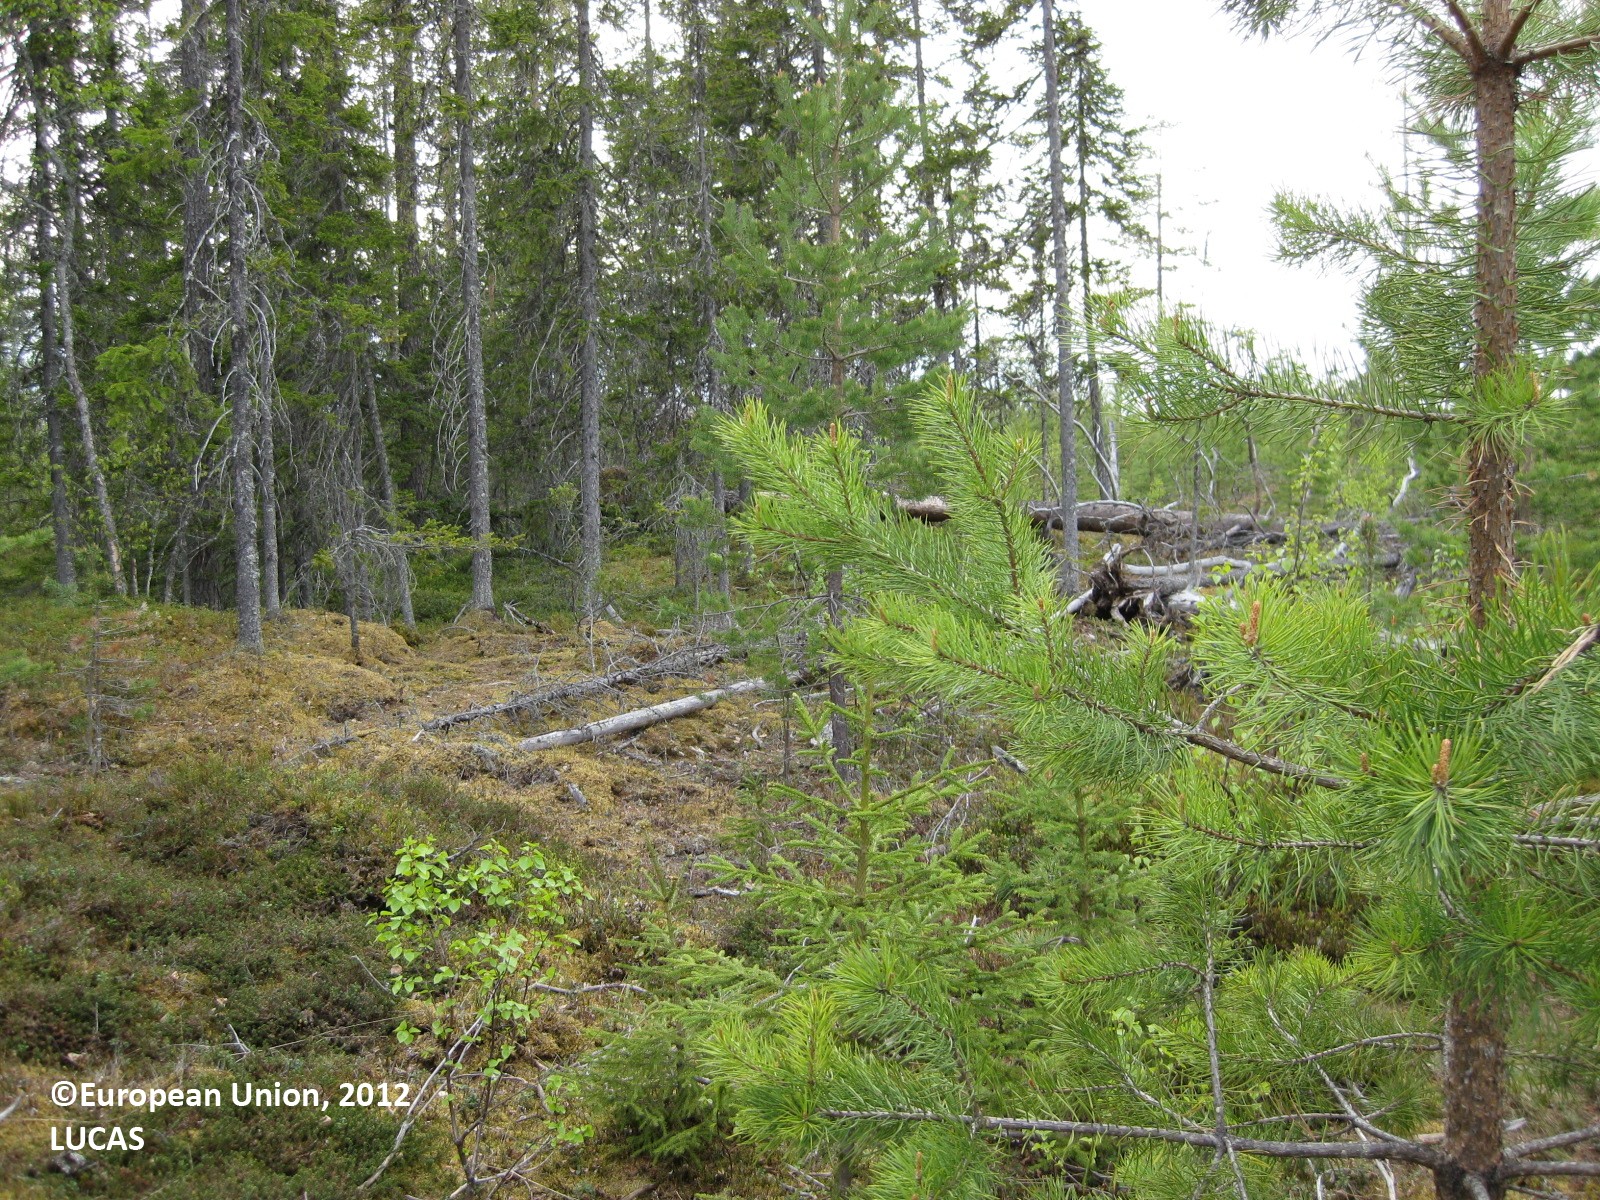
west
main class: Woodland
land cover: Pine dominated coniferous woodland
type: boreal forest
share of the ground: 50 - 75 %
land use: Forestry
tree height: < 5 m
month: June
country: FI
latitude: 65.3672
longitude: 29.3084
